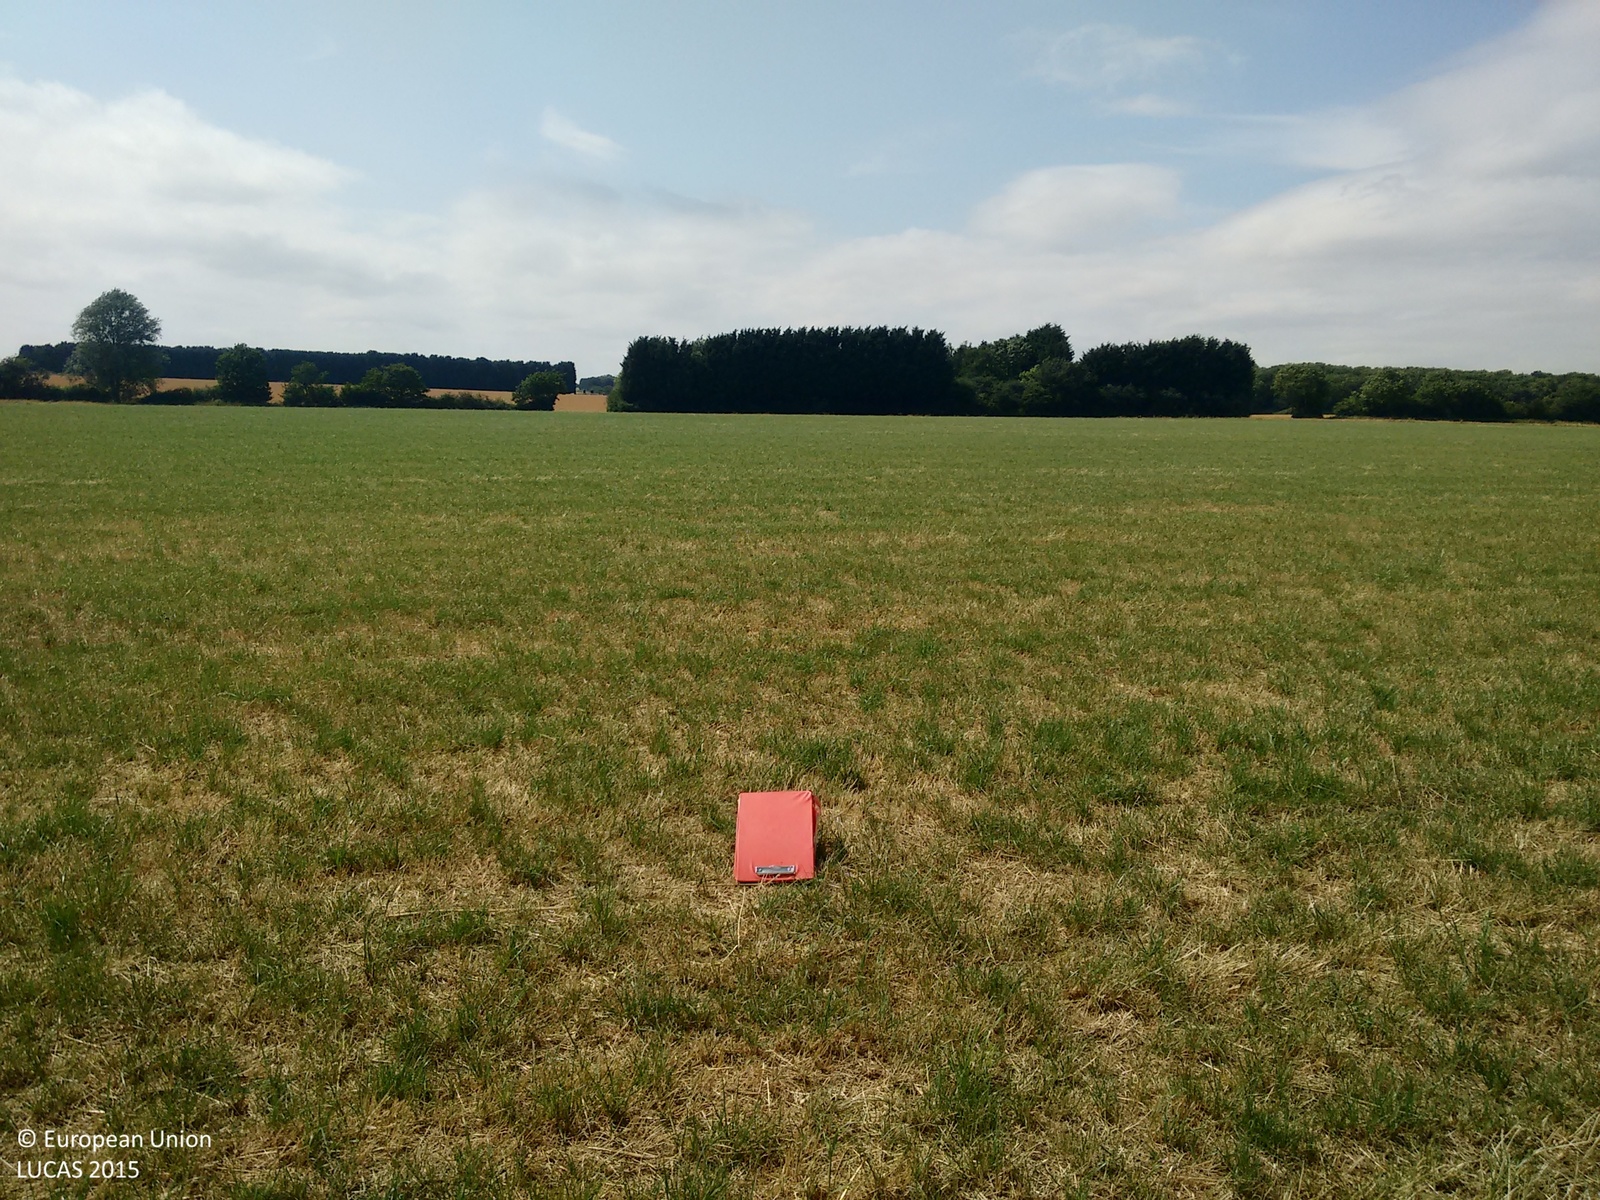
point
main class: Cropland
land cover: Temporary grasslands
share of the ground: > 75 %
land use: Agriculture (excluding fallow land and kitchen gardens)
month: July
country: GB
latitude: 51.7116
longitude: 0.3463
